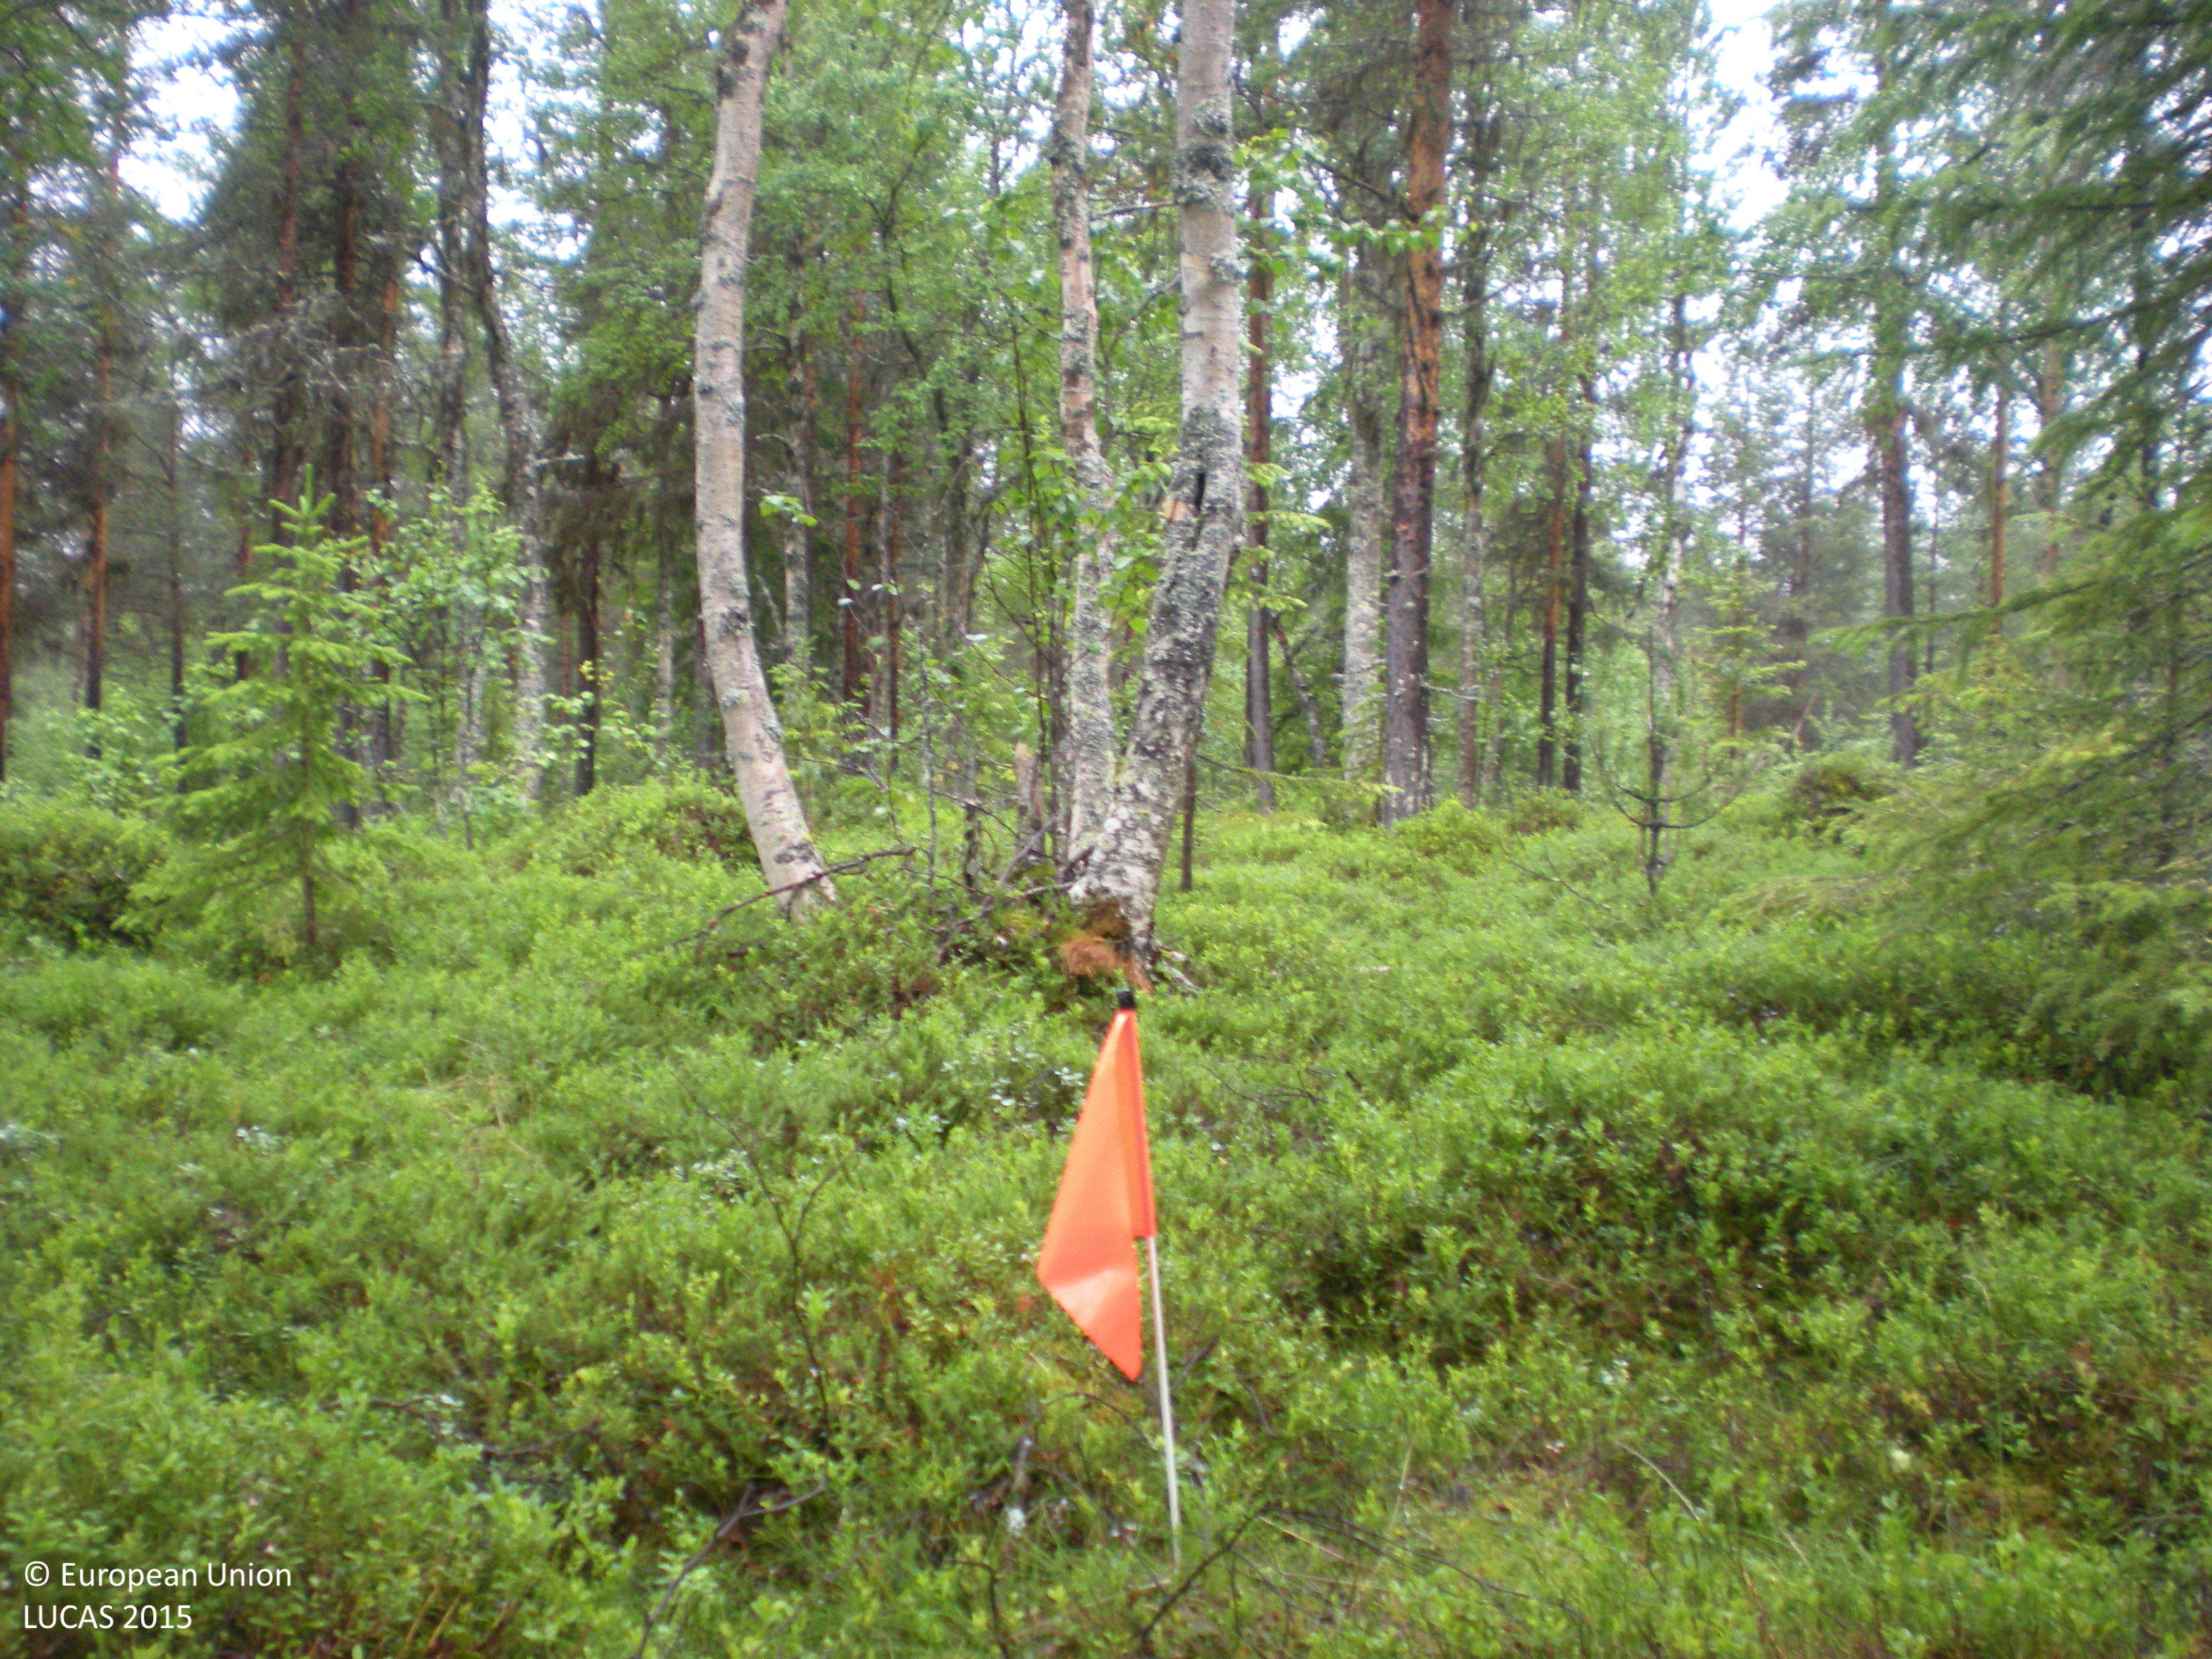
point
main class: Woodland
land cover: Pine dominated mixed woodland
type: boreal forest
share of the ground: 50 - 75 %
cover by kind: coniferous forest trees 40 %, broadleaved forest trees 25 %, shrubs 25 %, herbaceous plants 5 %, lichens and mosses 5 %
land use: Forestry
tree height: > 5 m
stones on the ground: 25 - 50 %
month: July
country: SE
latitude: 66.0078
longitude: 18.1323
